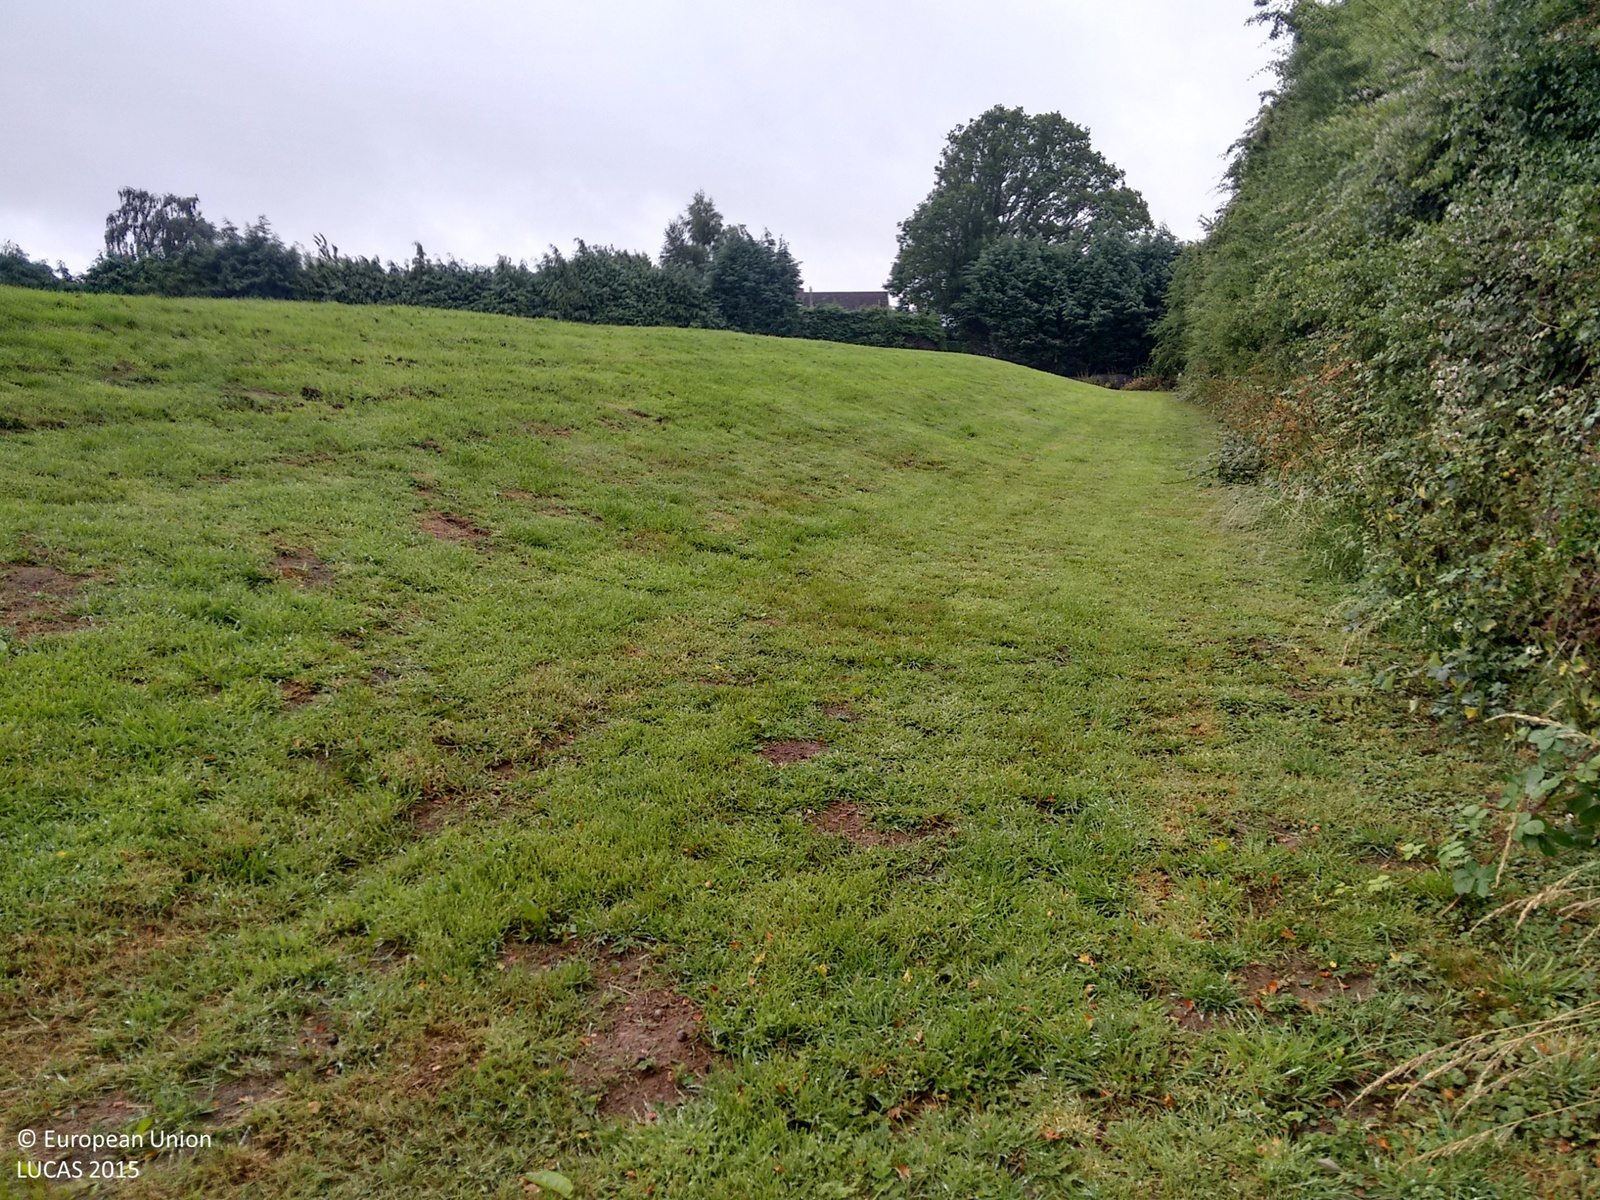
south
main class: Grassland
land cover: Grassland without tree/shrub cover
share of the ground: > 75 %
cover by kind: herbaceous plants 100 %
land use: Agriculture (excluding fallow land and kitchen gardens)
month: July
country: GB
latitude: 52.2456
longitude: -2.7991
